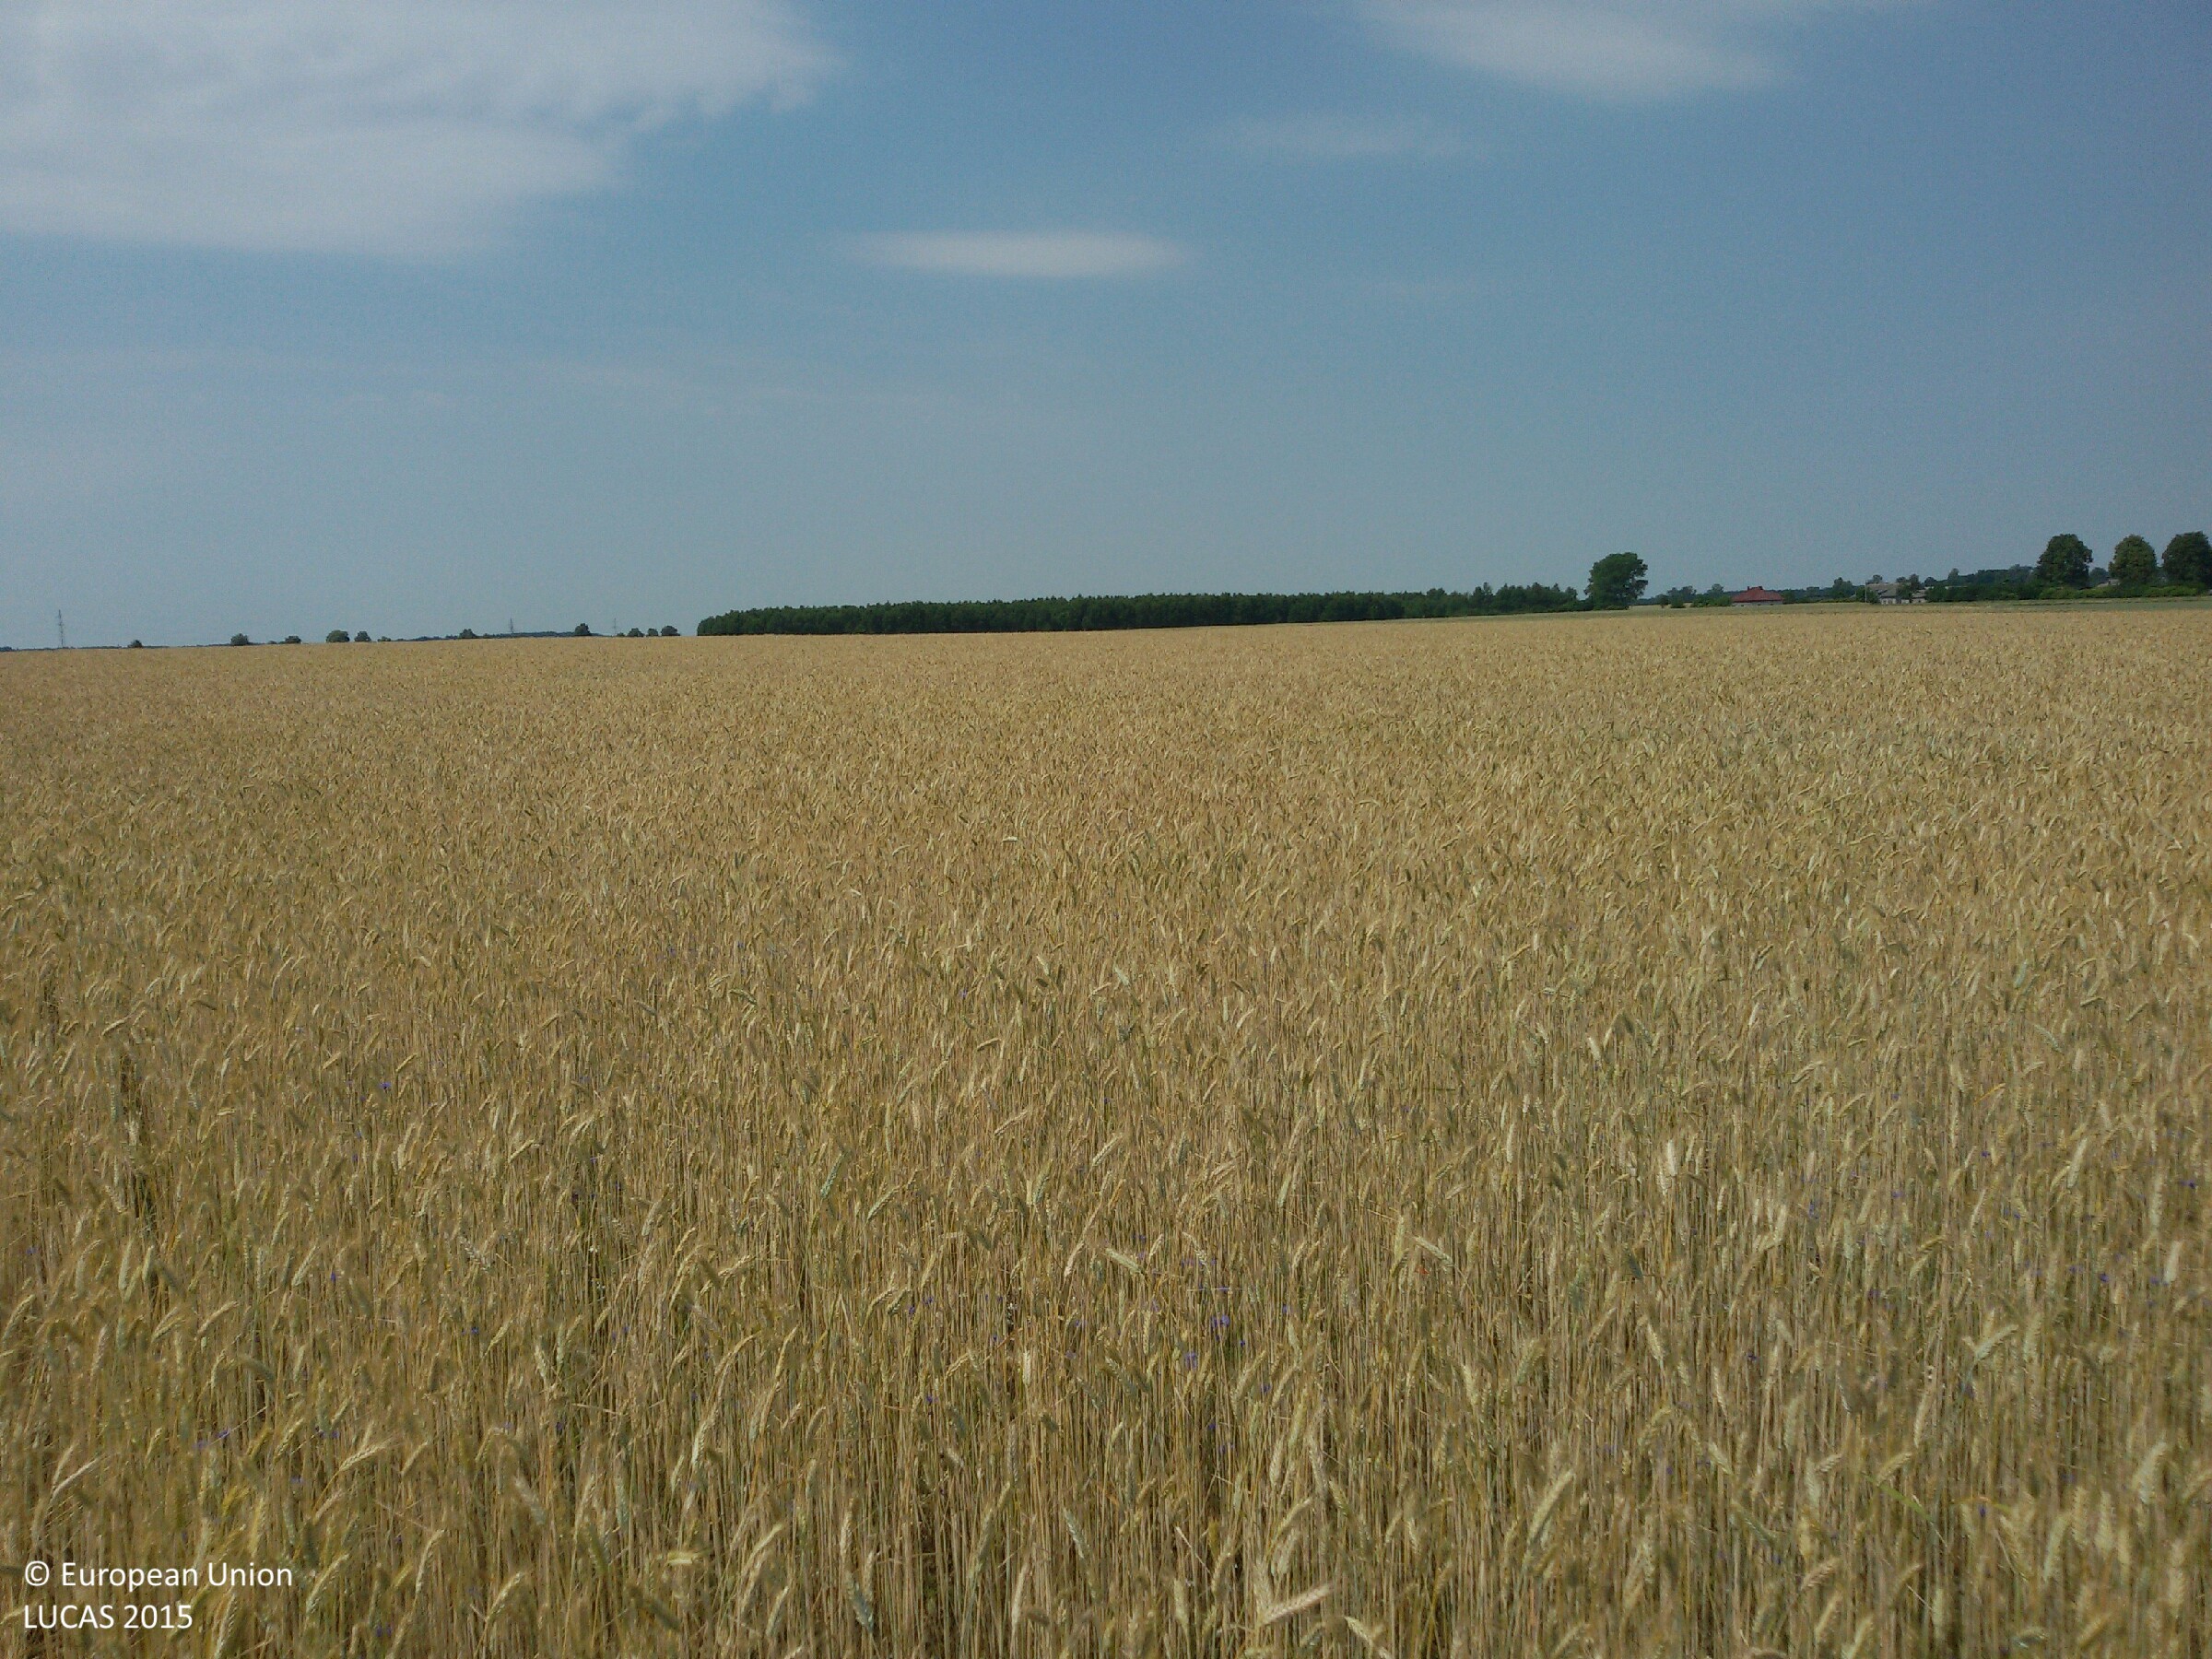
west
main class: Cropland
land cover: Common wheat
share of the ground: > 75 %
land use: Agriculture (excluding fallow land and kitchen gardens)
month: July
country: PL
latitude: 53.2869
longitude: 20.0982
